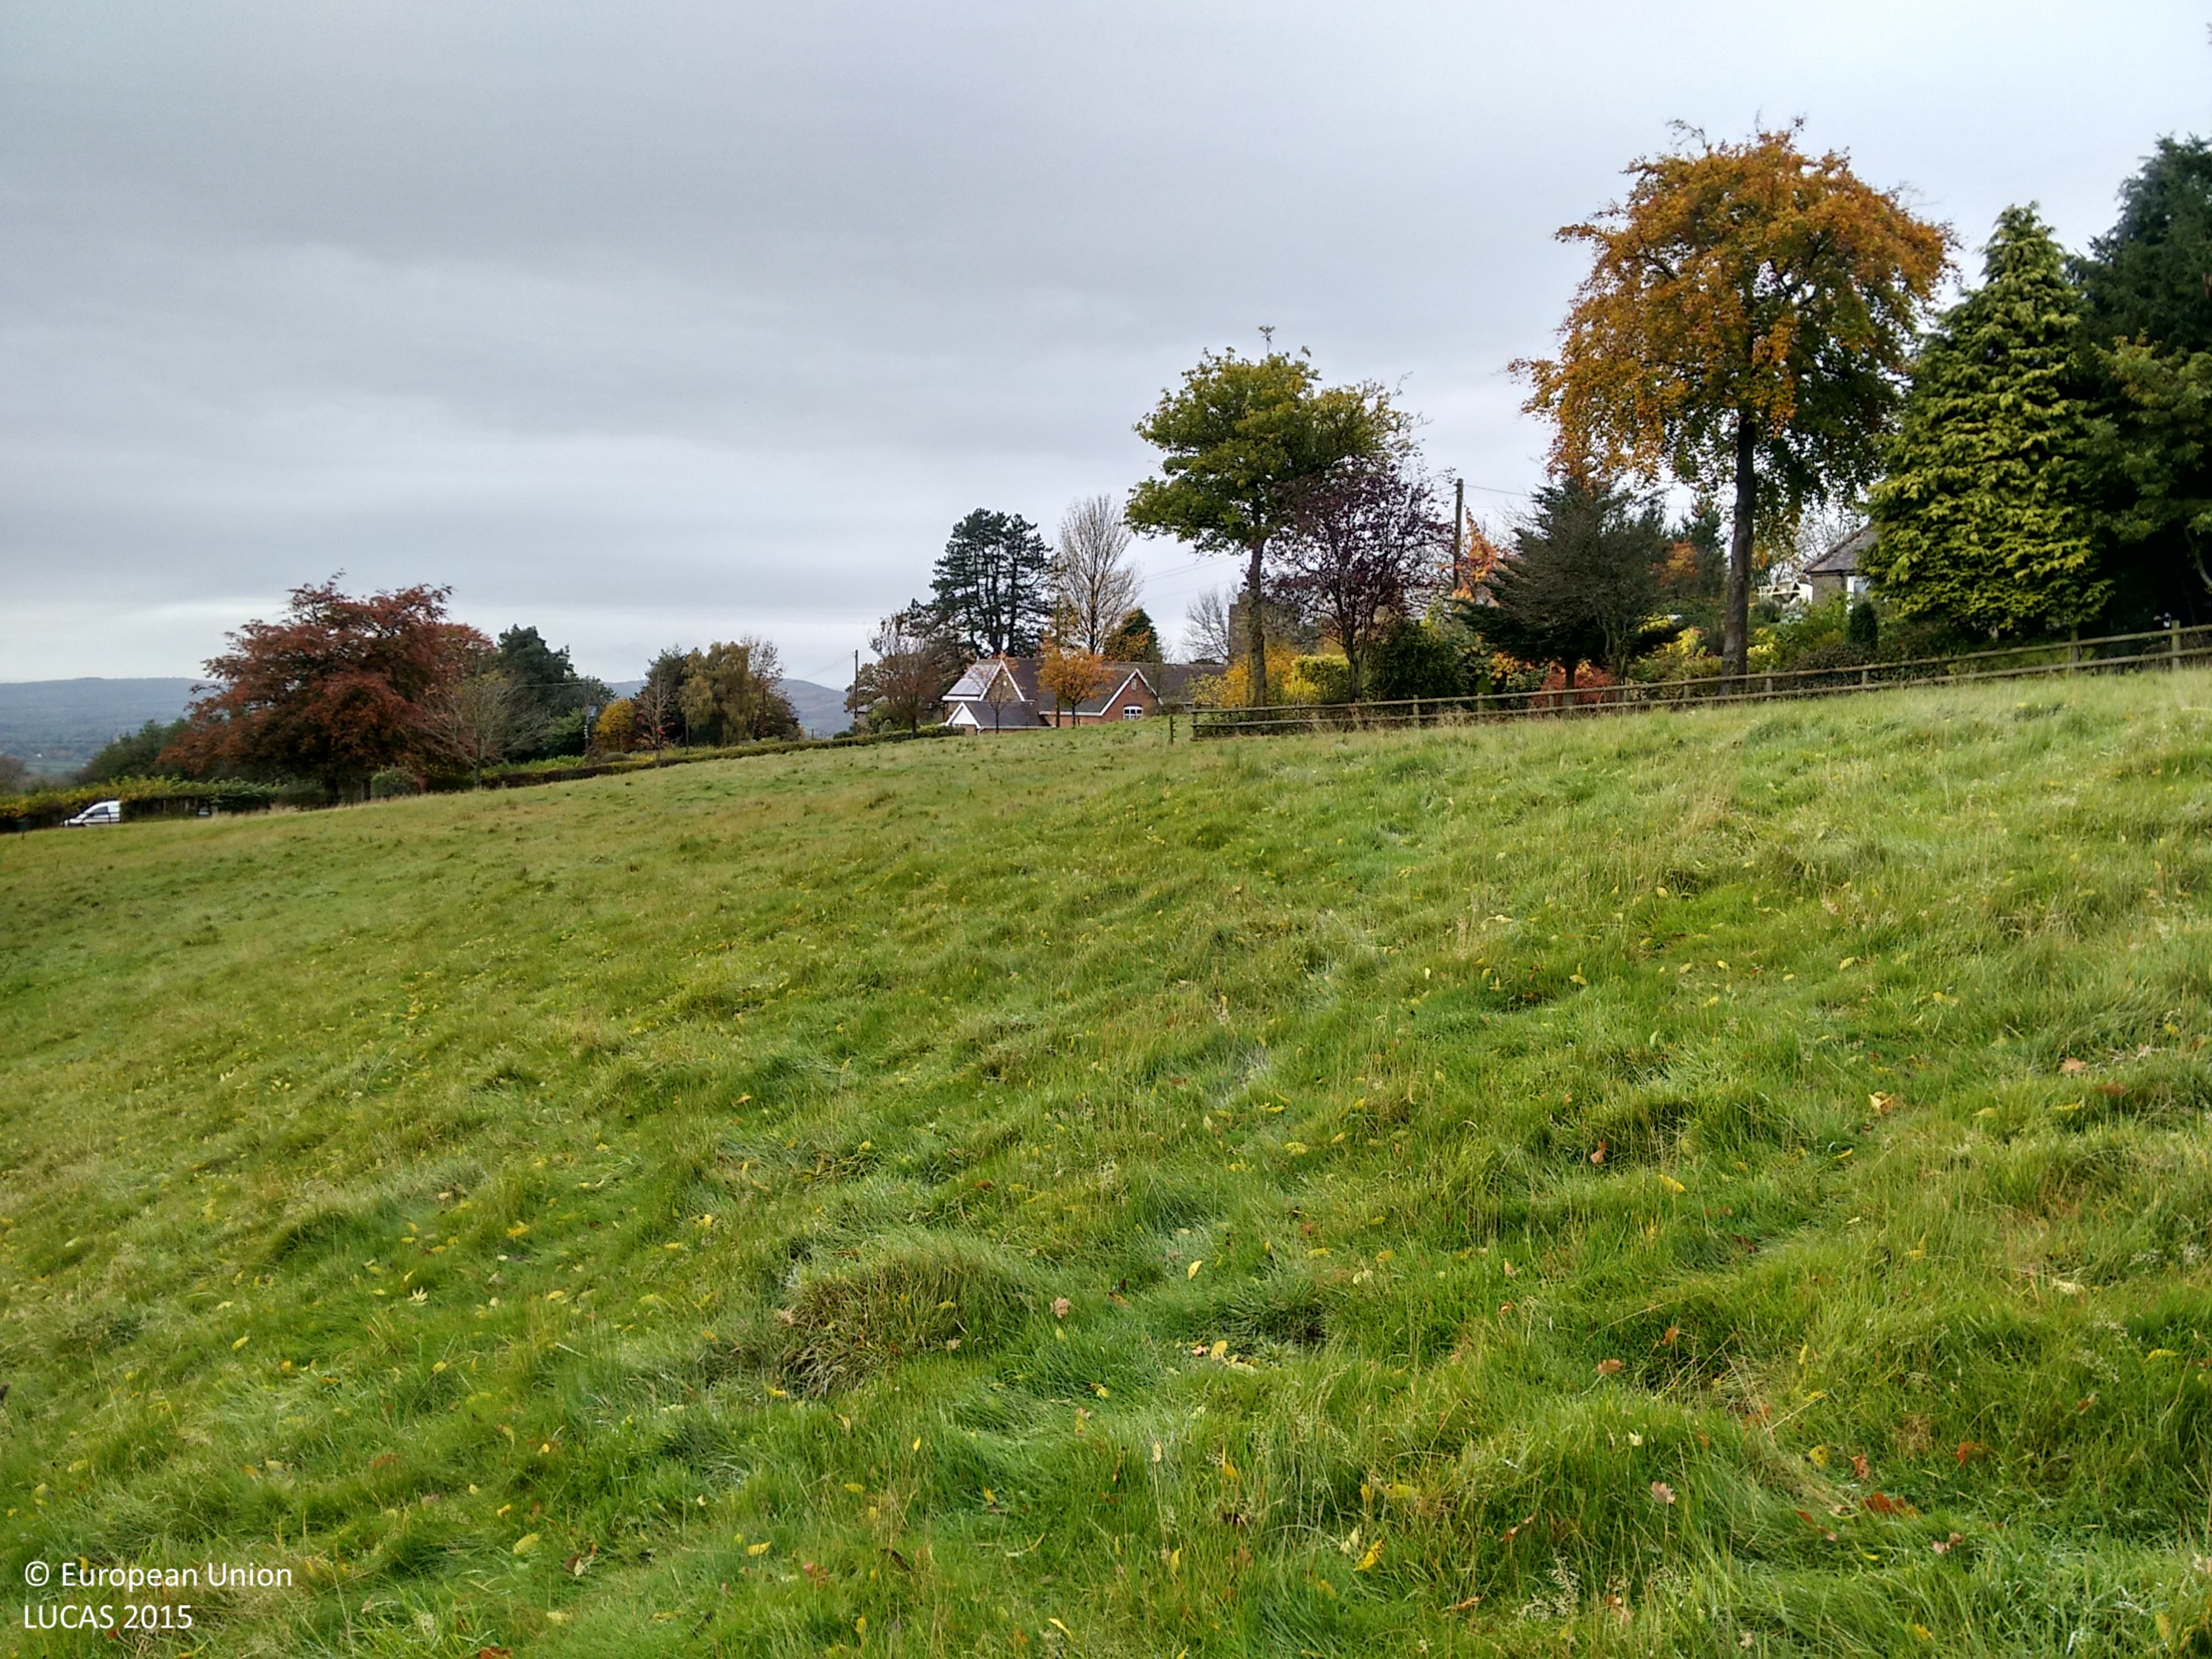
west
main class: Grassland
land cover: Grassland without tree/shrub cover
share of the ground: > 75 %
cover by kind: herbaceous plants 100 %
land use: Agriculture (excluding fallow land and kitchen gardens)
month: October
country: GB
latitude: 52.3734
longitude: -2.6272
